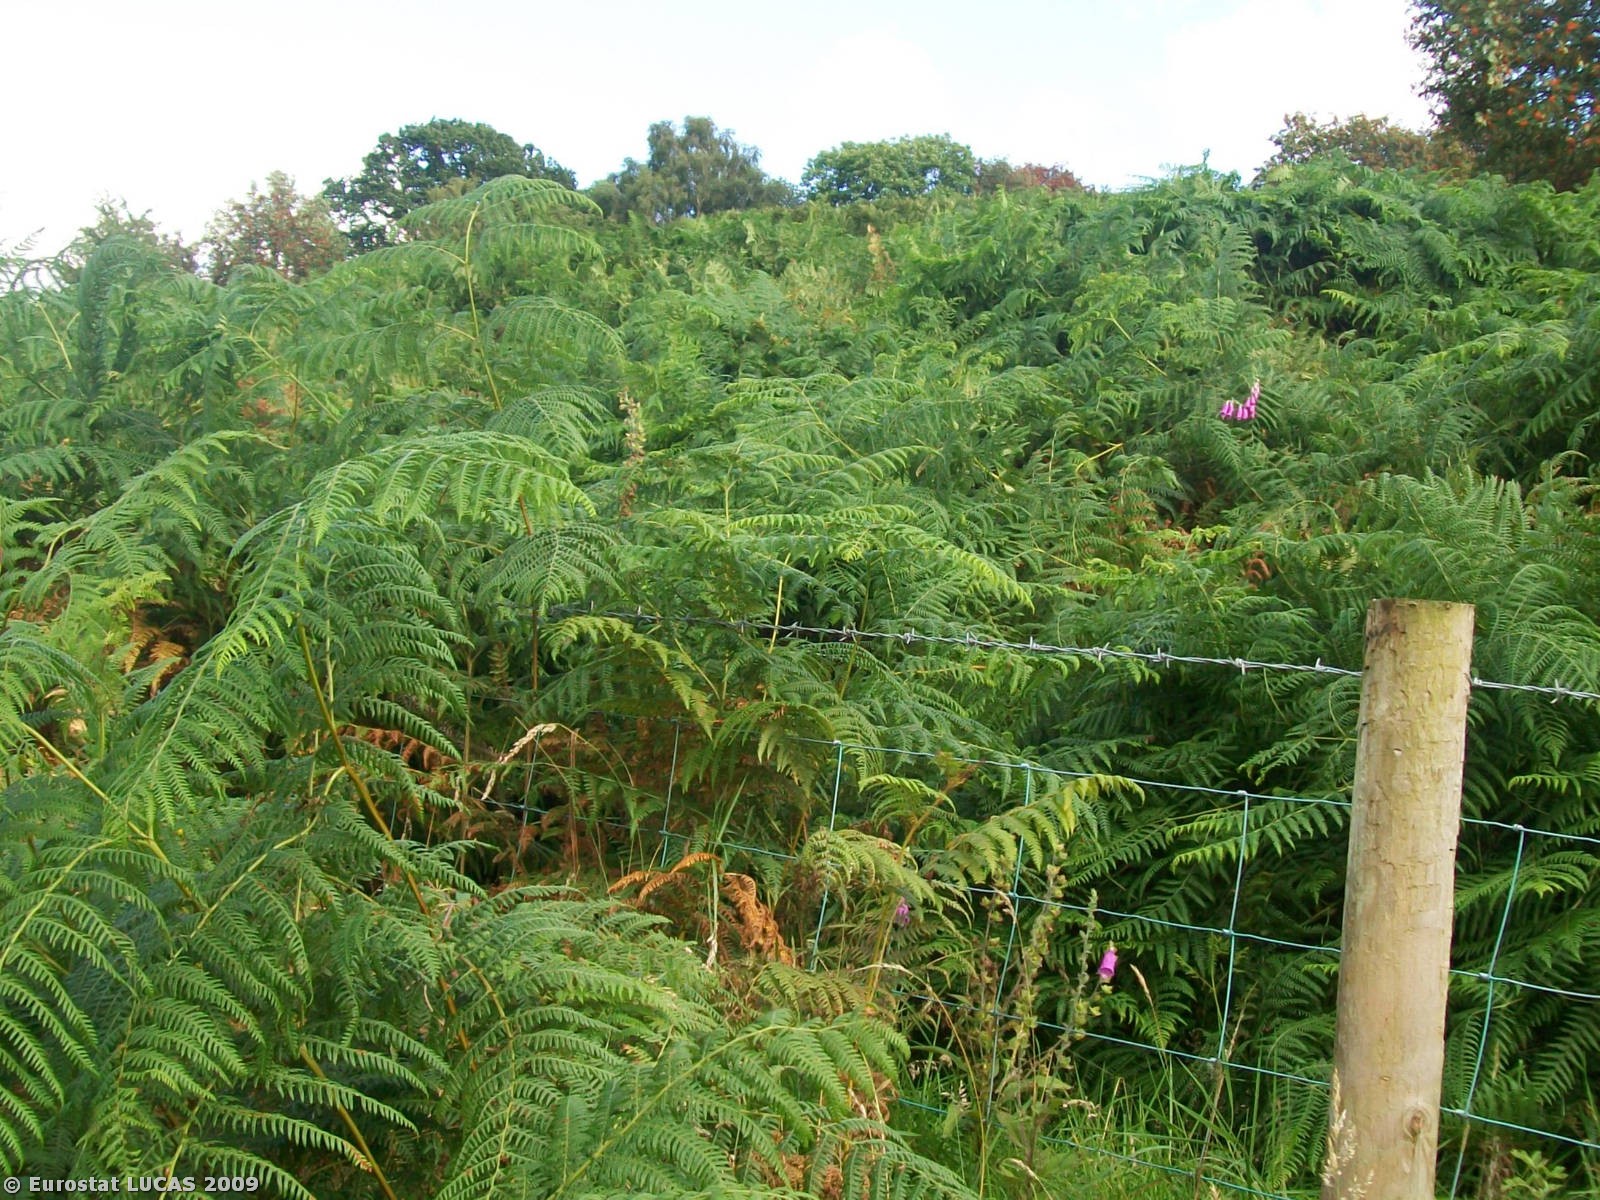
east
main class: Shrubland
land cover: Shrubland without tree cover
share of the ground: > 75 %
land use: Agriculture (excluding fallow land and kitchen gardens)
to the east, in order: Shrubland without tree cover
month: August
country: GB
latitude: 52.9202
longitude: -3.4542
